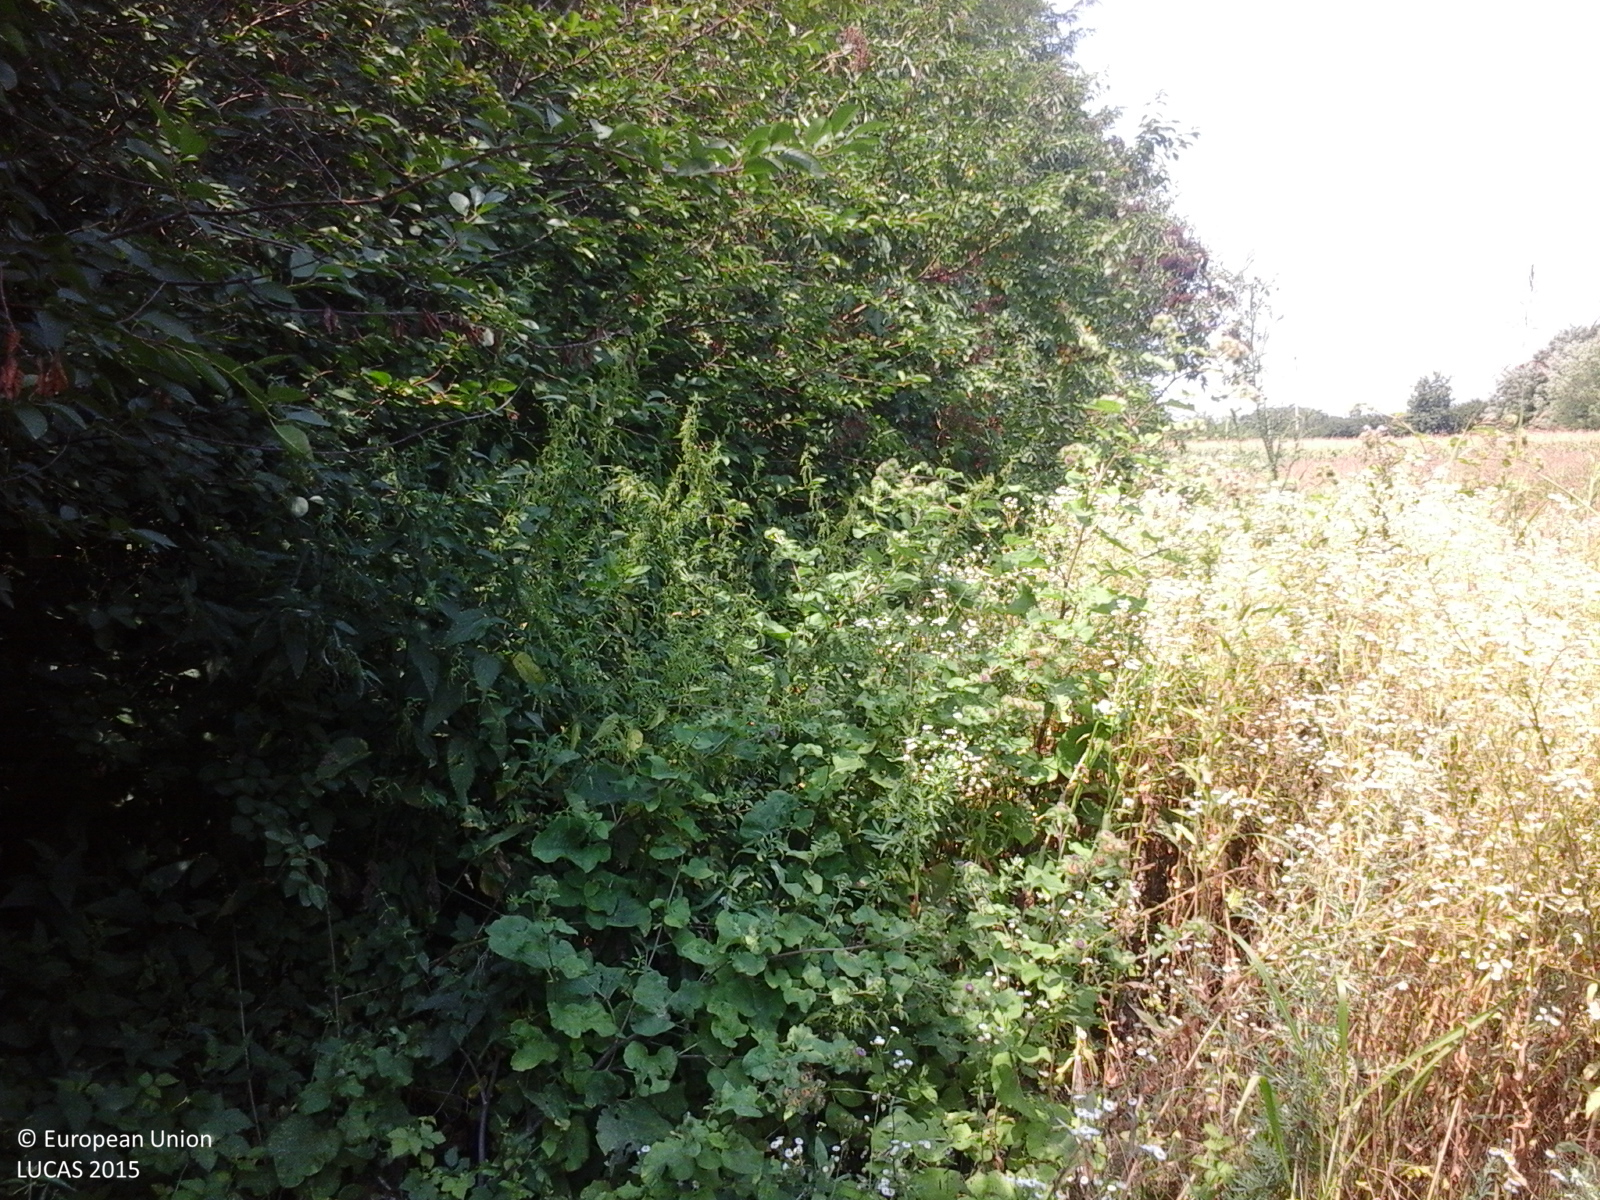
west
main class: Grassland
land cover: Spontaneously vegetated surfaces
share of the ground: > 75 %
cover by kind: herbaceous plants 100 %
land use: Fallow land
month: July
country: RO
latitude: 44.5980
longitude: 26.5070
